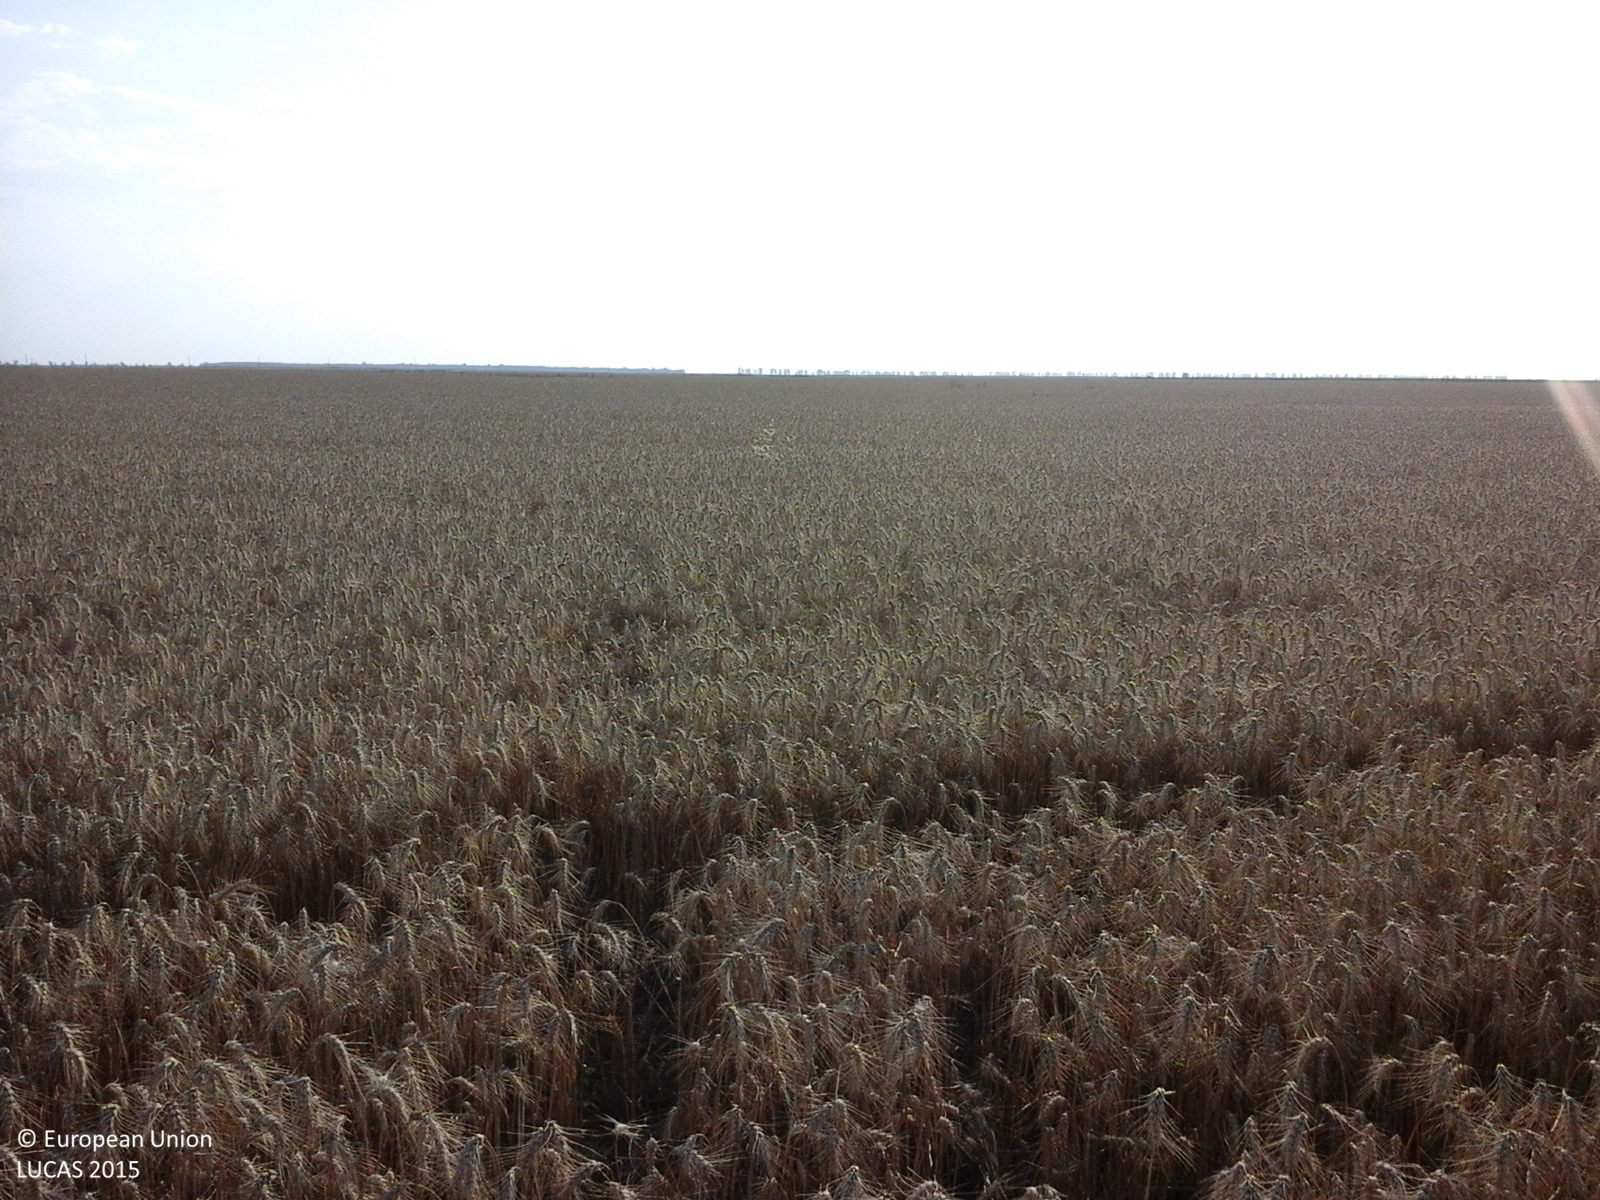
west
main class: Cropland
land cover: Common wheat
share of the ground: > 75 %
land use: Agriculture (excluding fallow land and kitchen gardens)
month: July
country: RO
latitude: 44.0314
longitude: 25.0633
